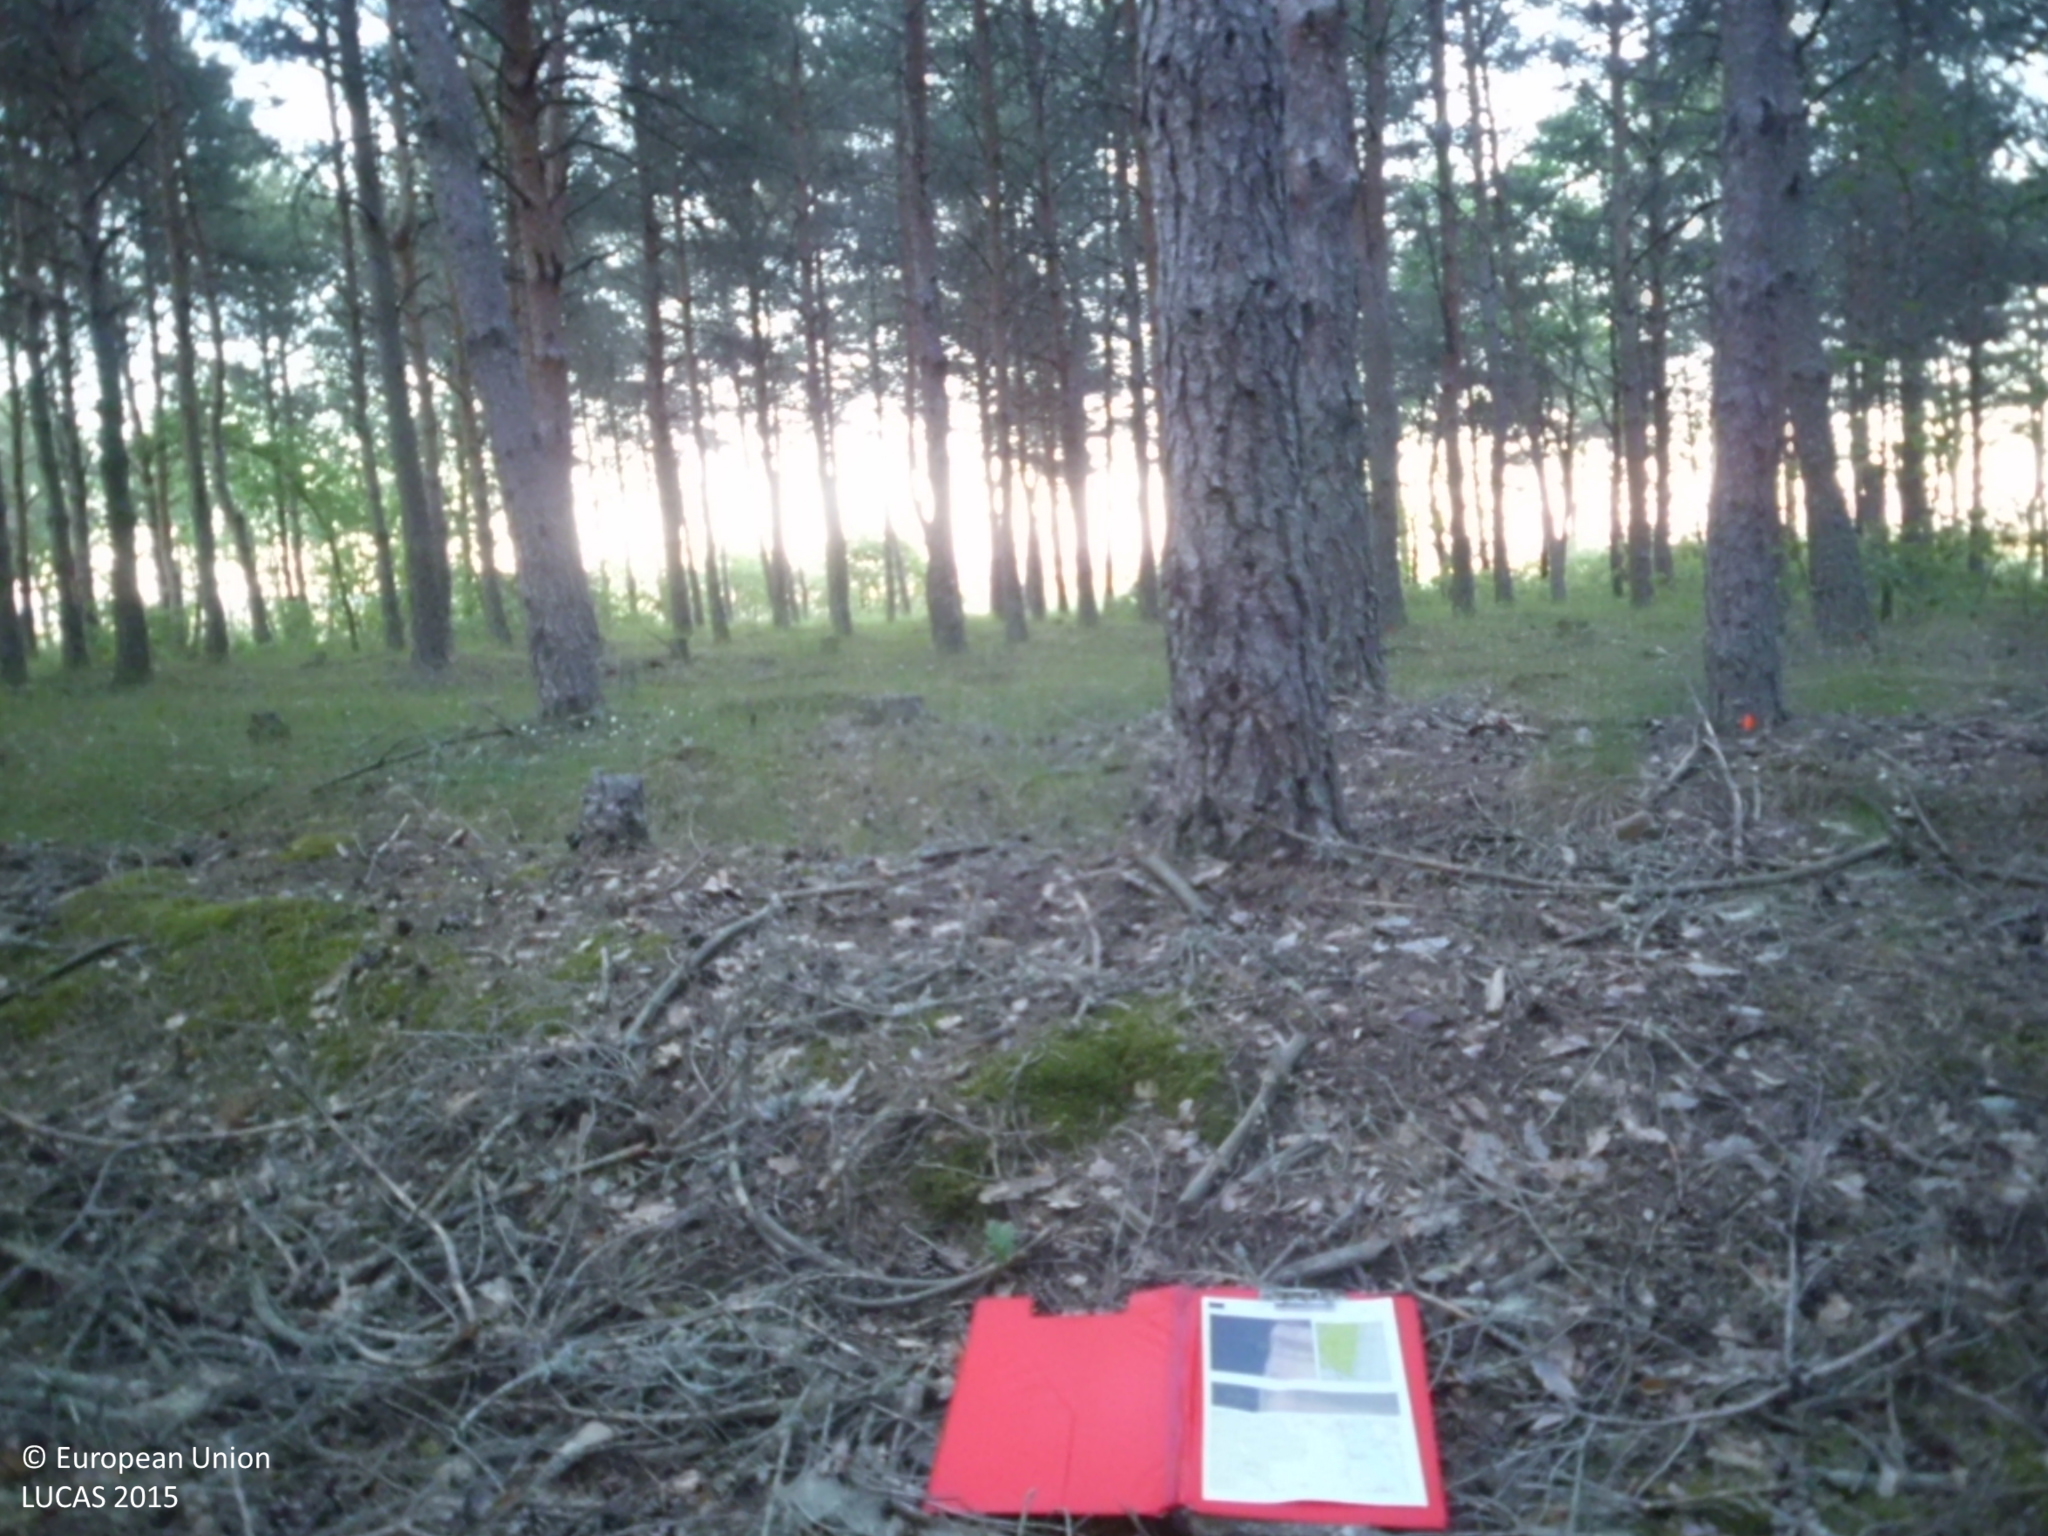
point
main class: Woodland
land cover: Pine dominated coniferous woodland
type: coniferous forest of the mediterranean region
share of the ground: > 75 %
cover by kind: coniferous forest trees 100 %
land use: Forestry
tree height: > 5 m
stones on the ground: > 50 %
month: May
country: ES
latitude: 42.5983
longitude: -4.8420
